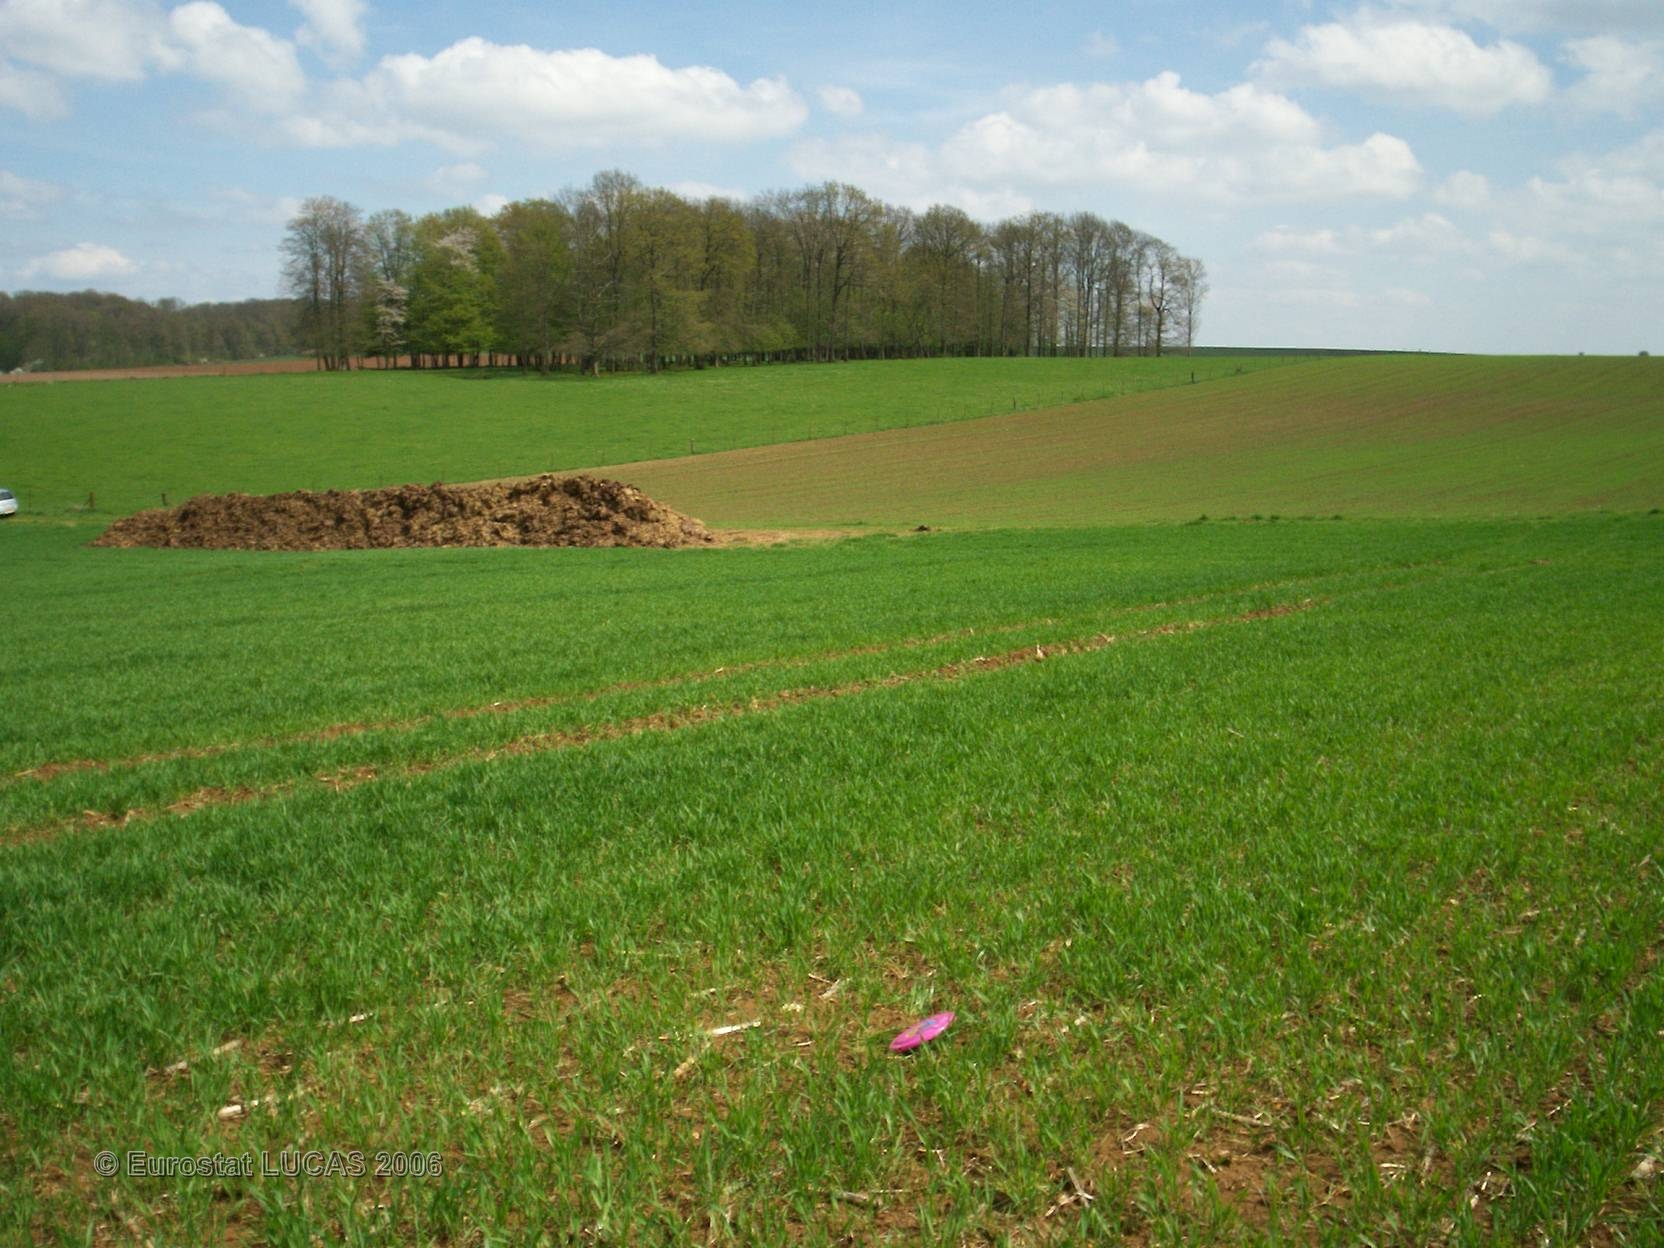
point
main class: Cropland
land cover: Common wheat
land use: Agriculture (excluding fallow land and kitchen gardens)
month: May
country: FR
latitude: 49.7928
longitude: 4.3697
